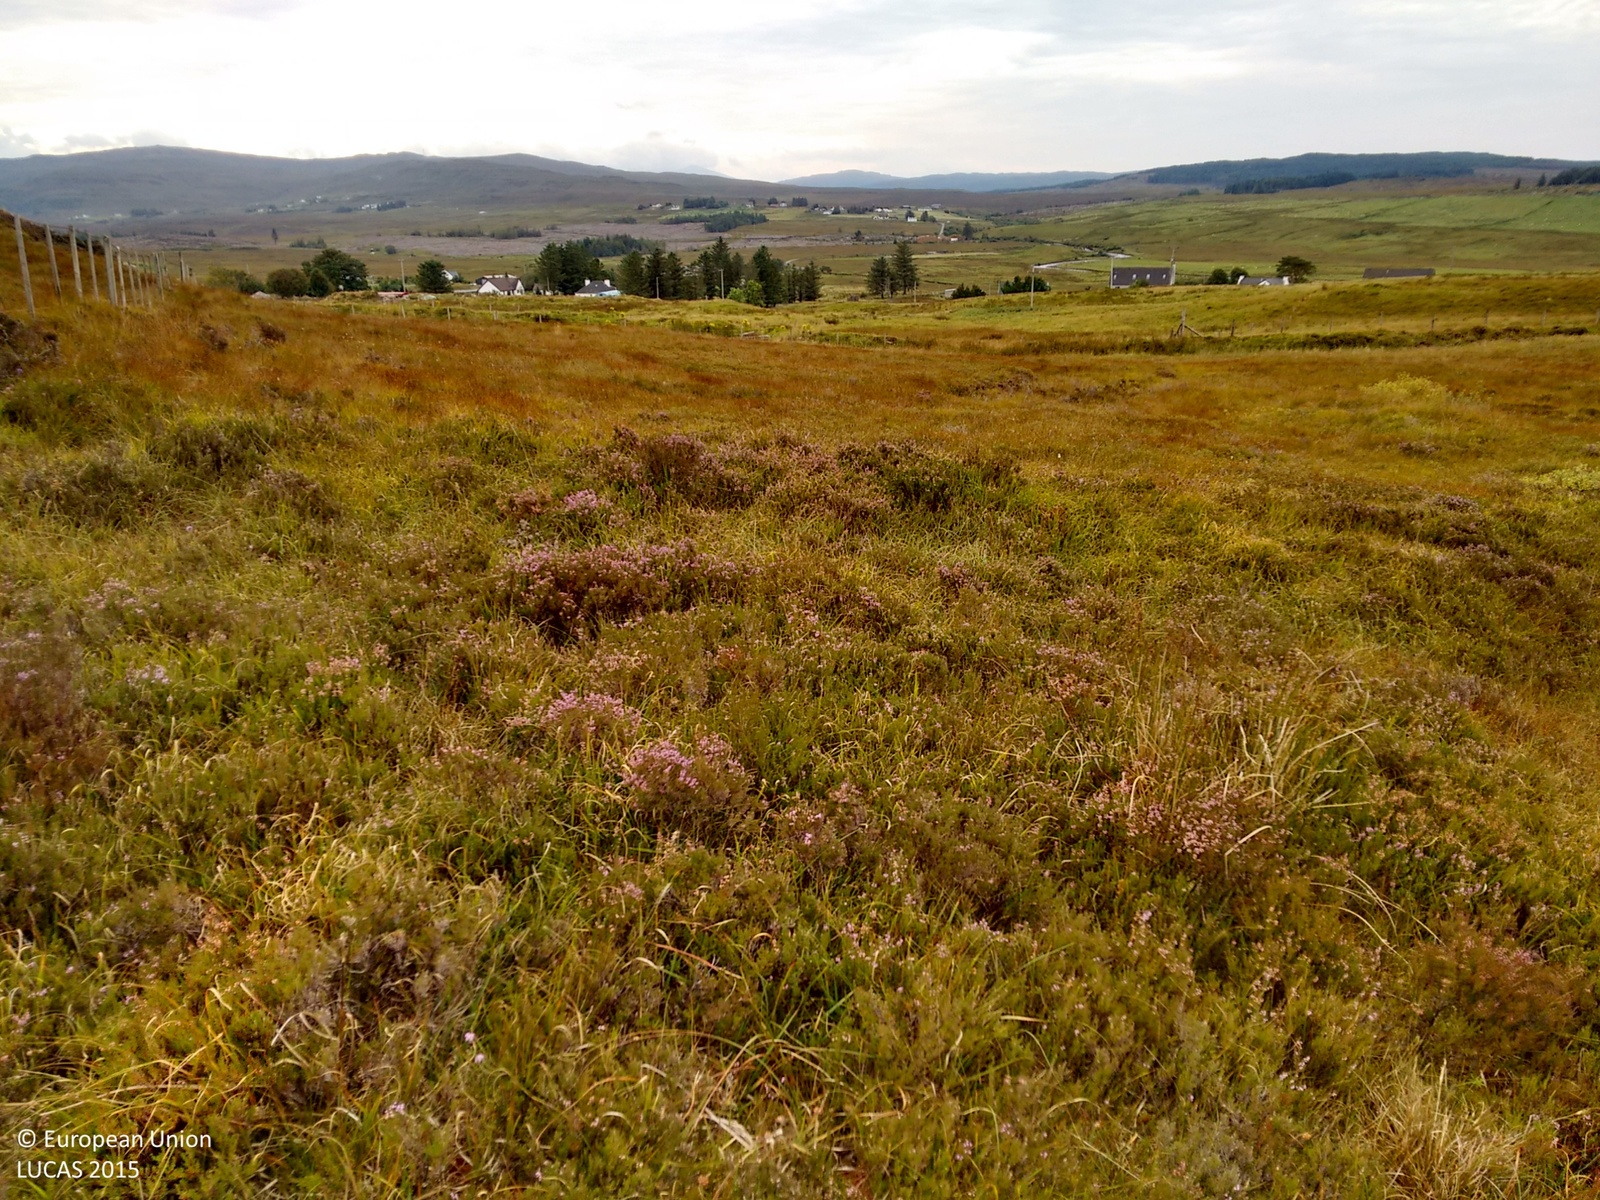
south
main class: Shrubland
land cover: Shrubland without tree cover
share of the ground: > 75 %
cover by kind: shrubs 80 %, herbaceous plants 20 %
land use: Agriculture (excluding fallow land and kitchen gardens)
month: September
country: GB
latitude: 57.4549
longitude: -6.2867
